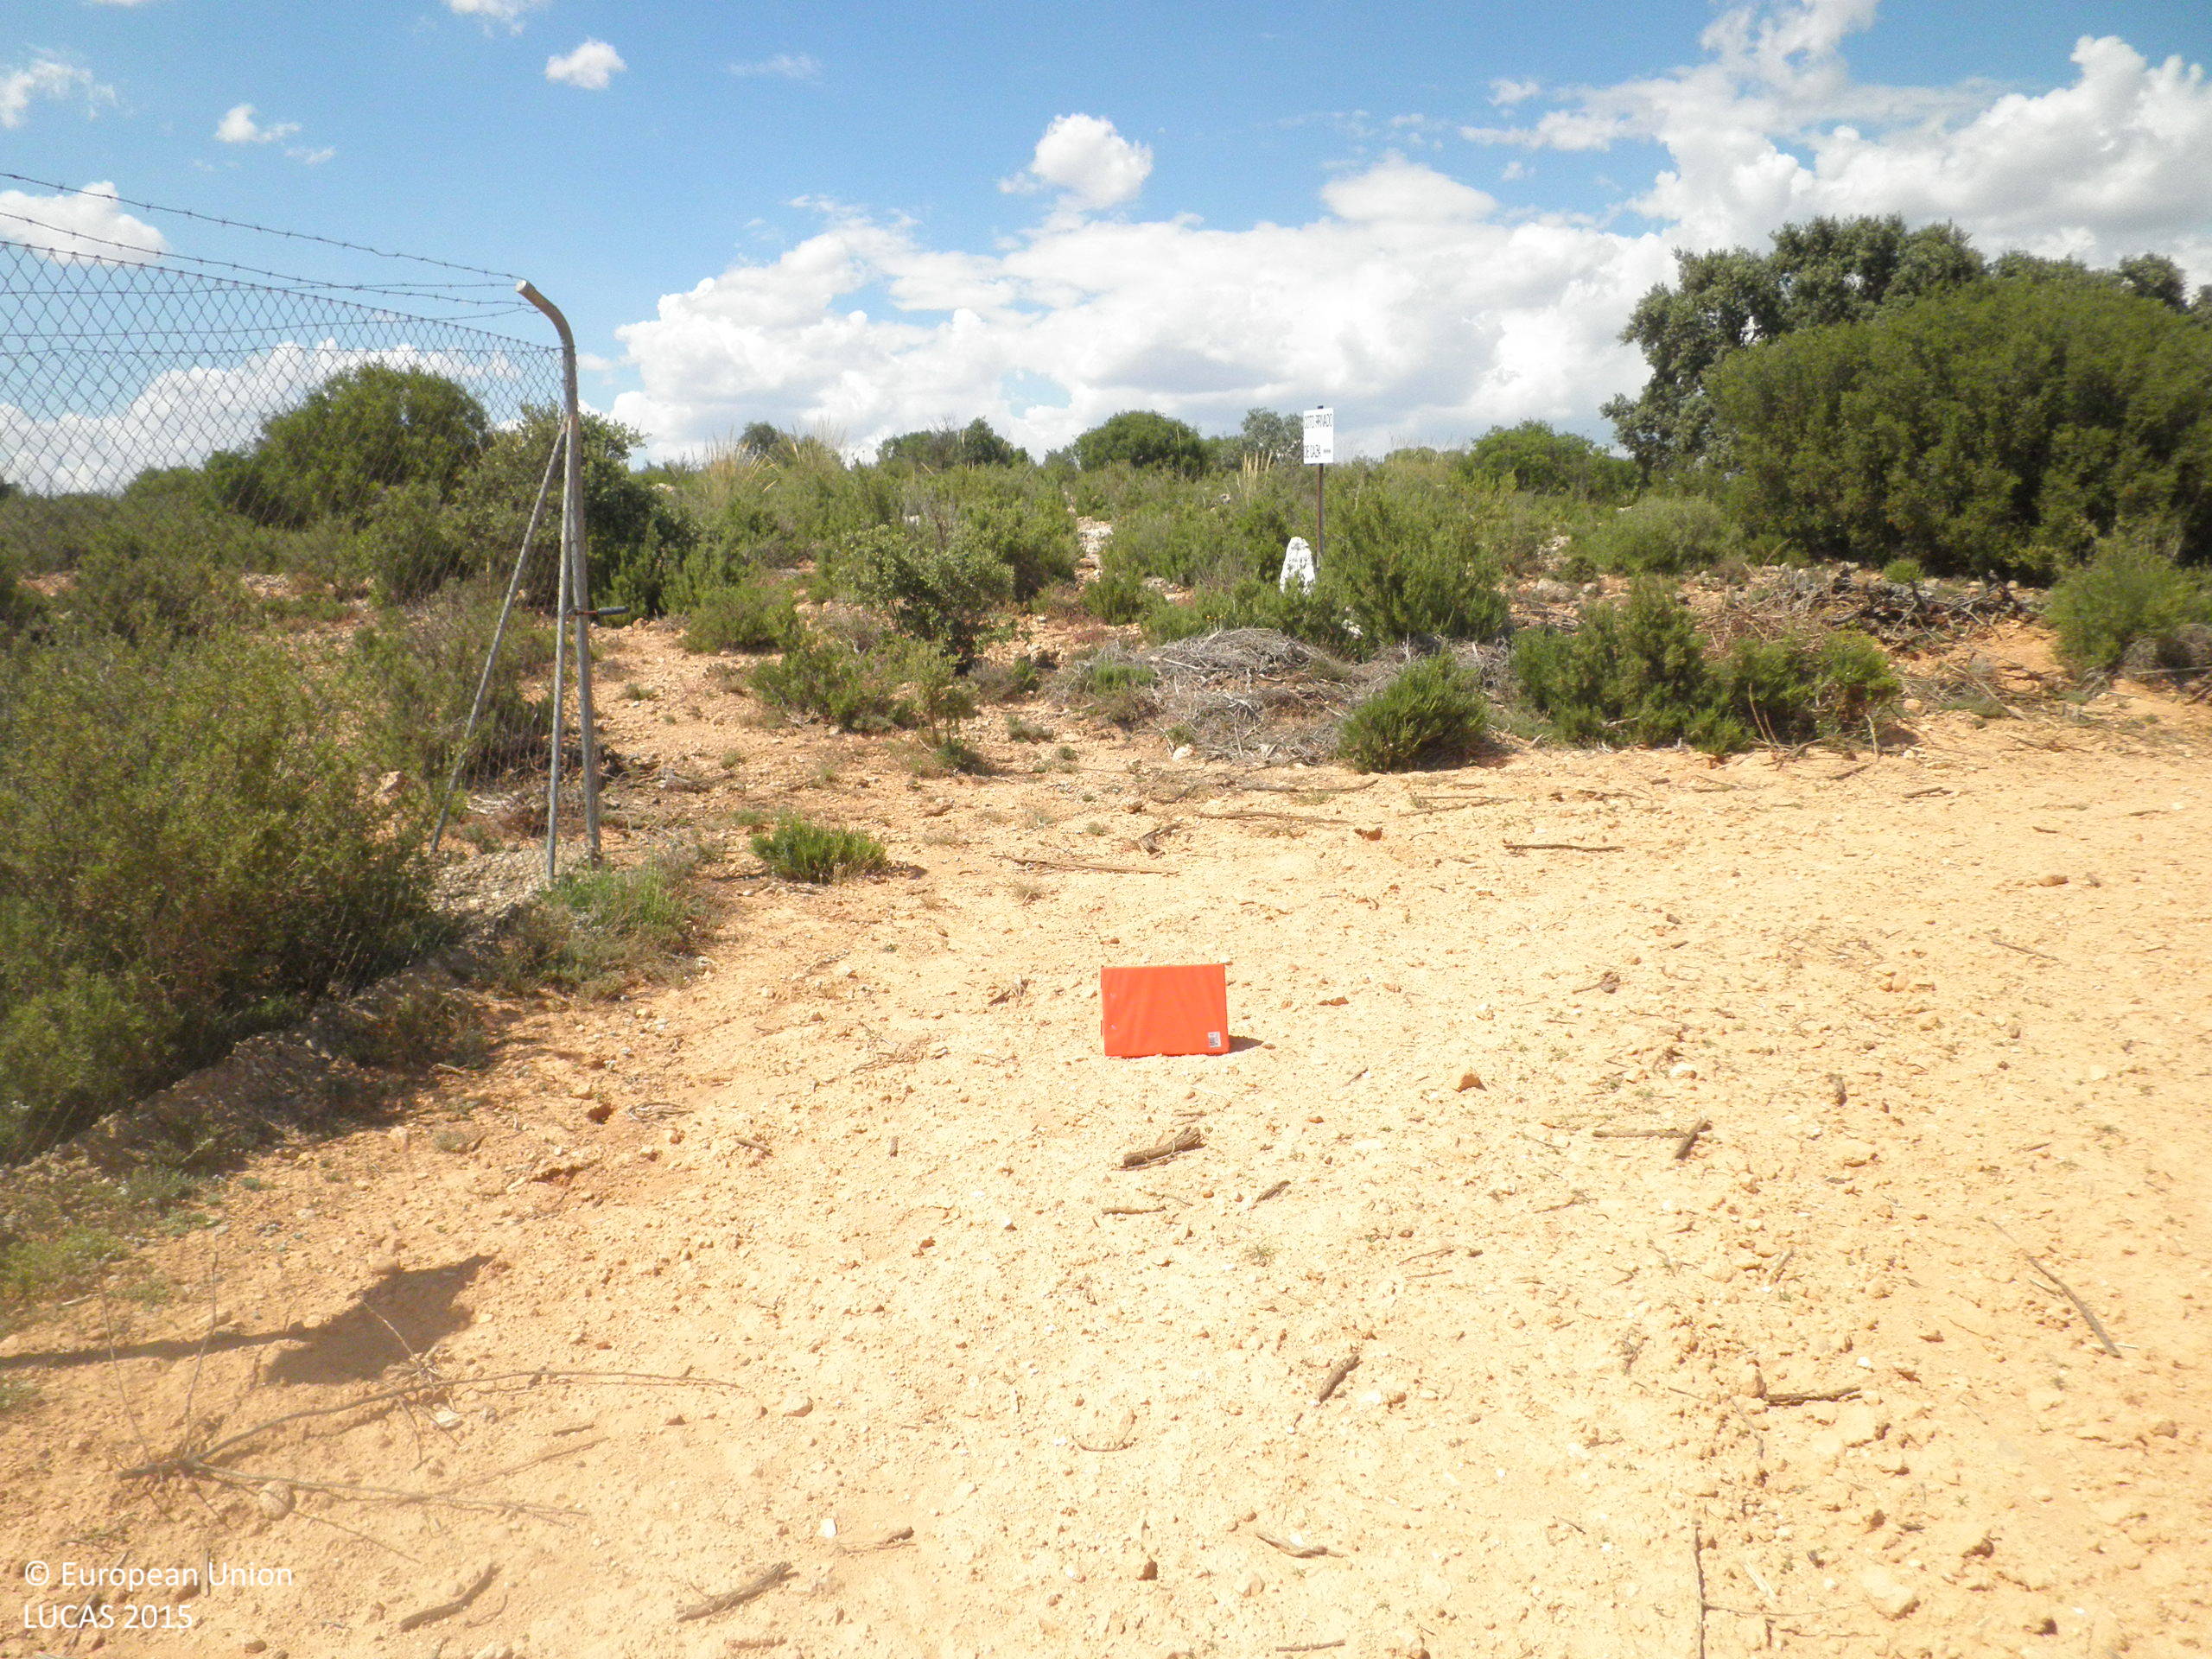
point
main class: Cropland
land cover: Nuts trees
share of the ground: < 10 %
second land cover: Other bare soil
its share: > 75 %
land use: Agriculture (excluding fallow land and kitchen gardens)
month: June
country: ES
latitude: 39.4816
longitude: -1.7829
